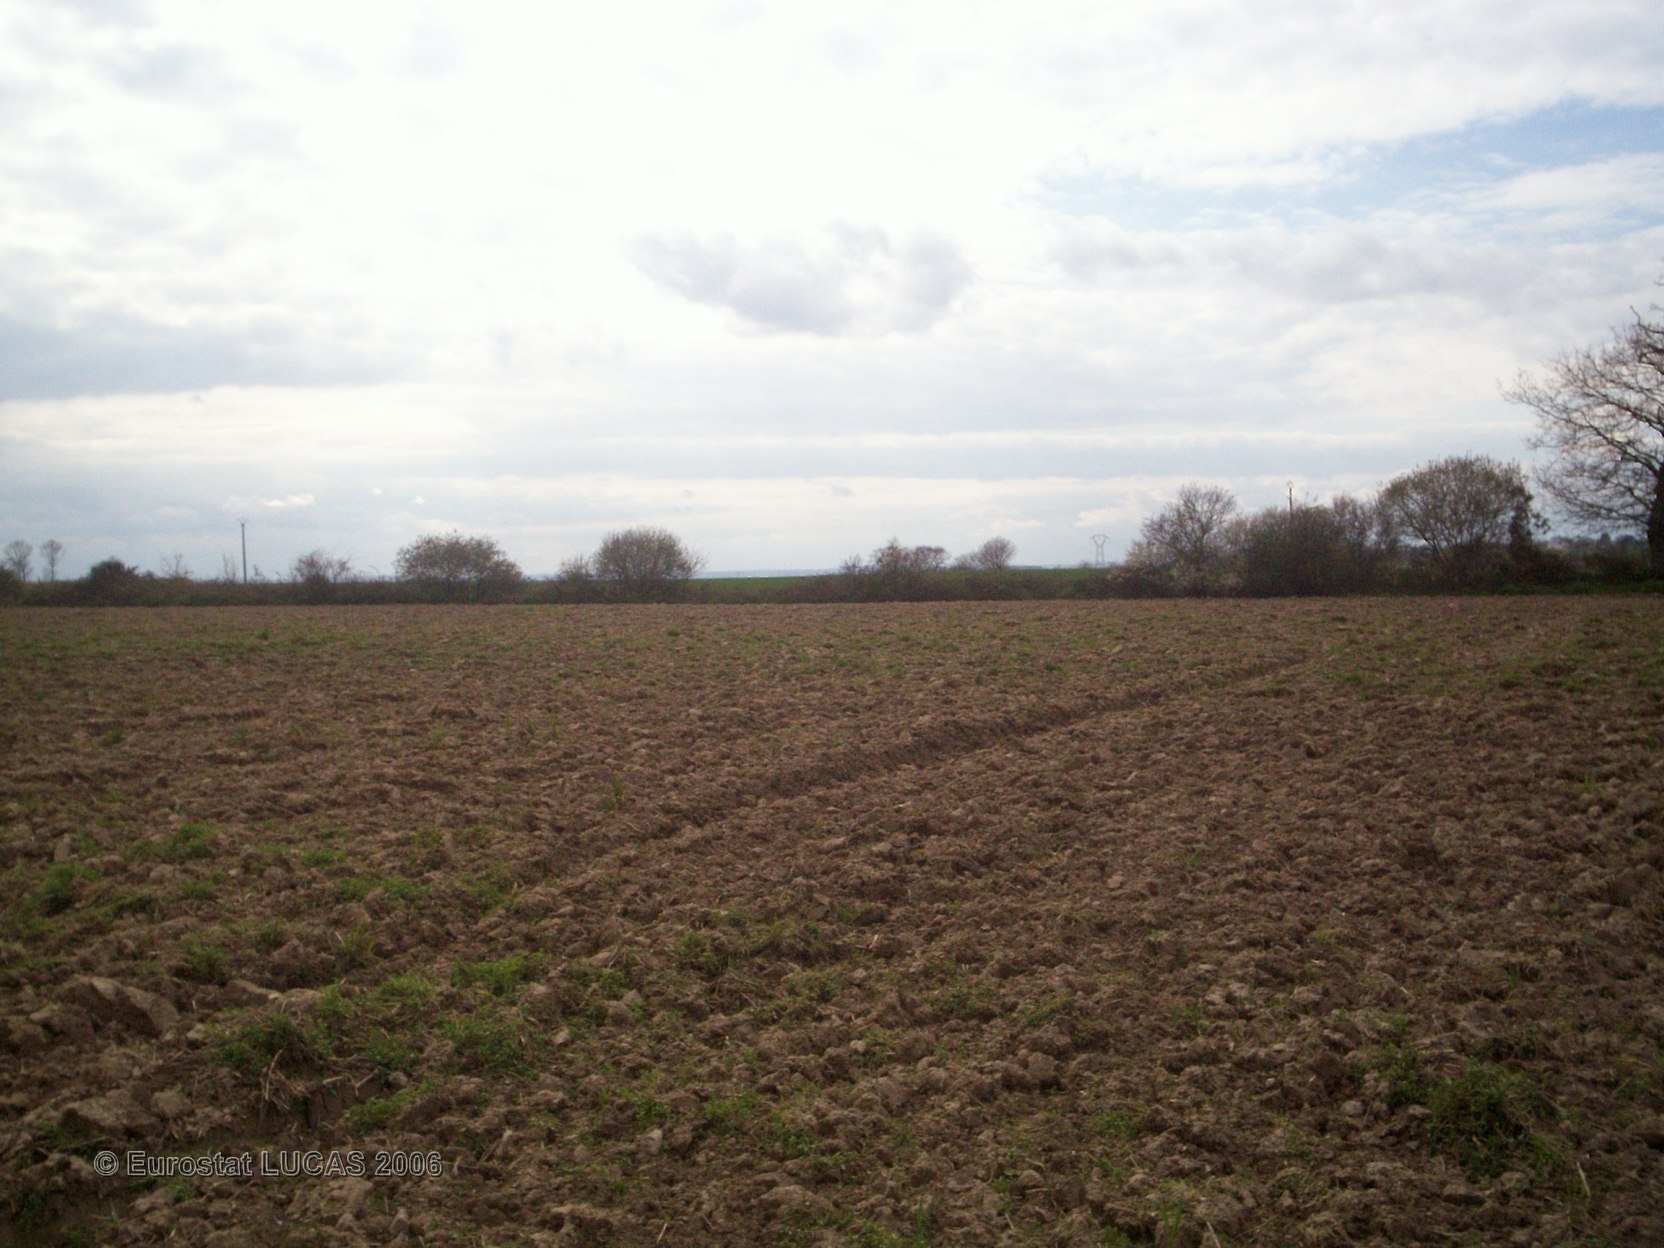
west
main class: Cropland
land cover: Maize
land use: Agriculture (excluding fallow land and kitchen gardens)
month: June
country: FR
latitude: 48.4892
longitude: -2.5239
